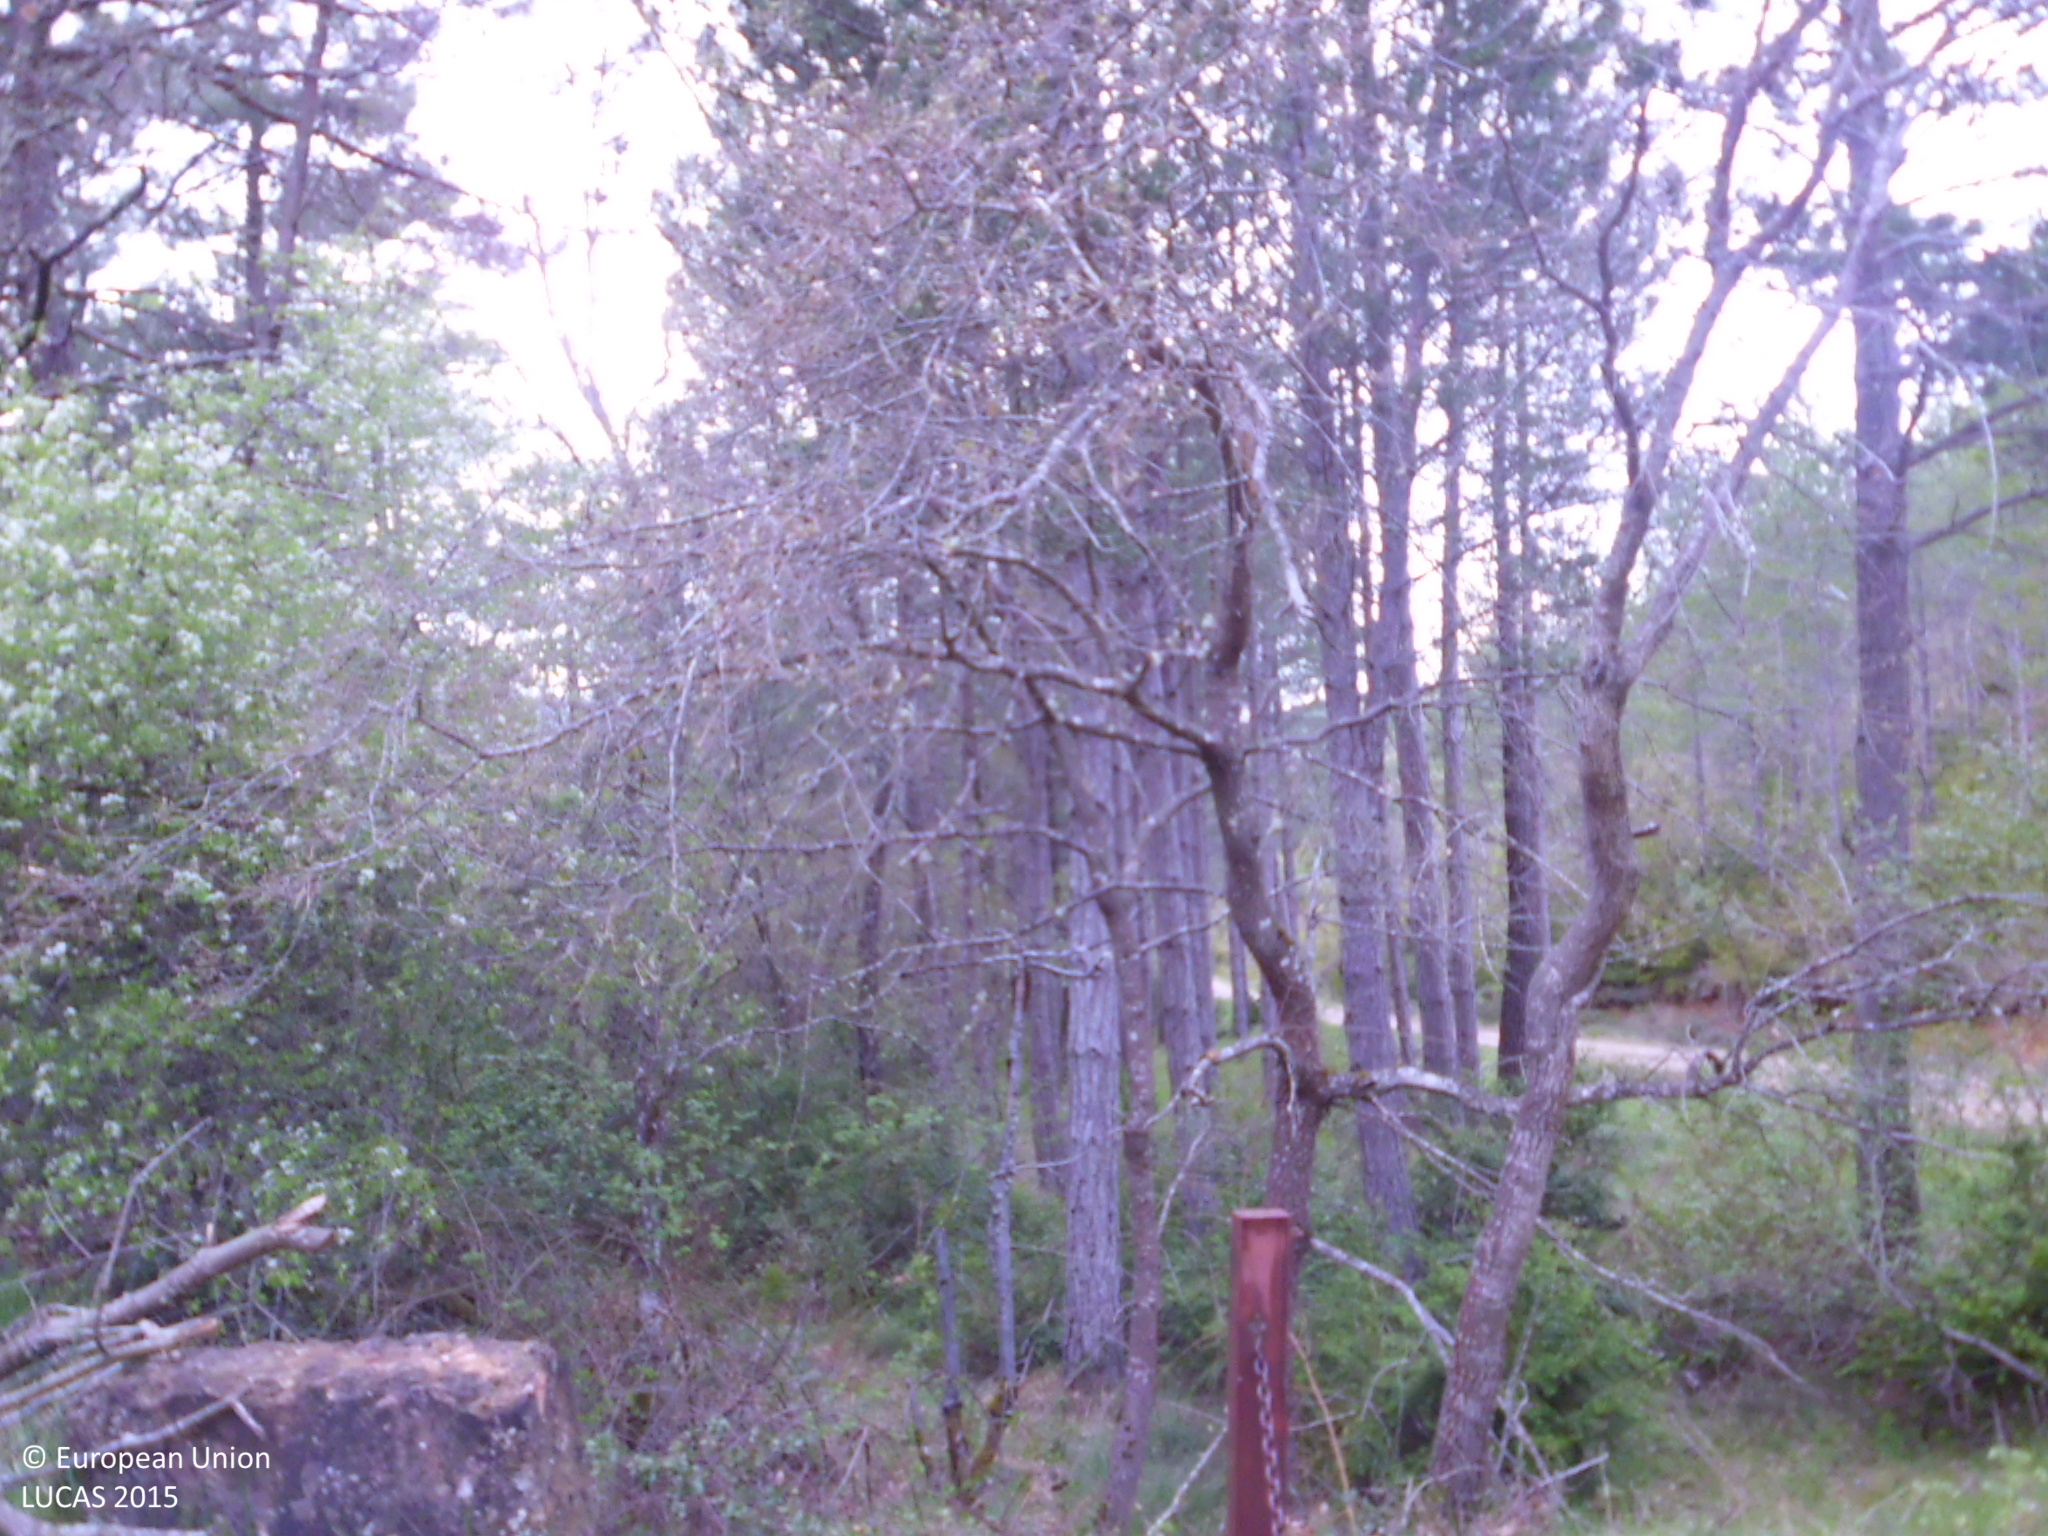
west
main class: Woodland
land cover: Pine dominated mixed woodland
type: coniferous forest of the mediterranean region
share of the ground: > 75 %
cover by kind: coniferous forest trees 55 %, broadleaved forest trees 20 %, shrubs 15 %, herbaceous plants 10 %
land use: Semi-natural and natural areas not in use
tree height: > 5 m
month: April
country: ES
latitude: 42.7945
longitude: -3.4491
